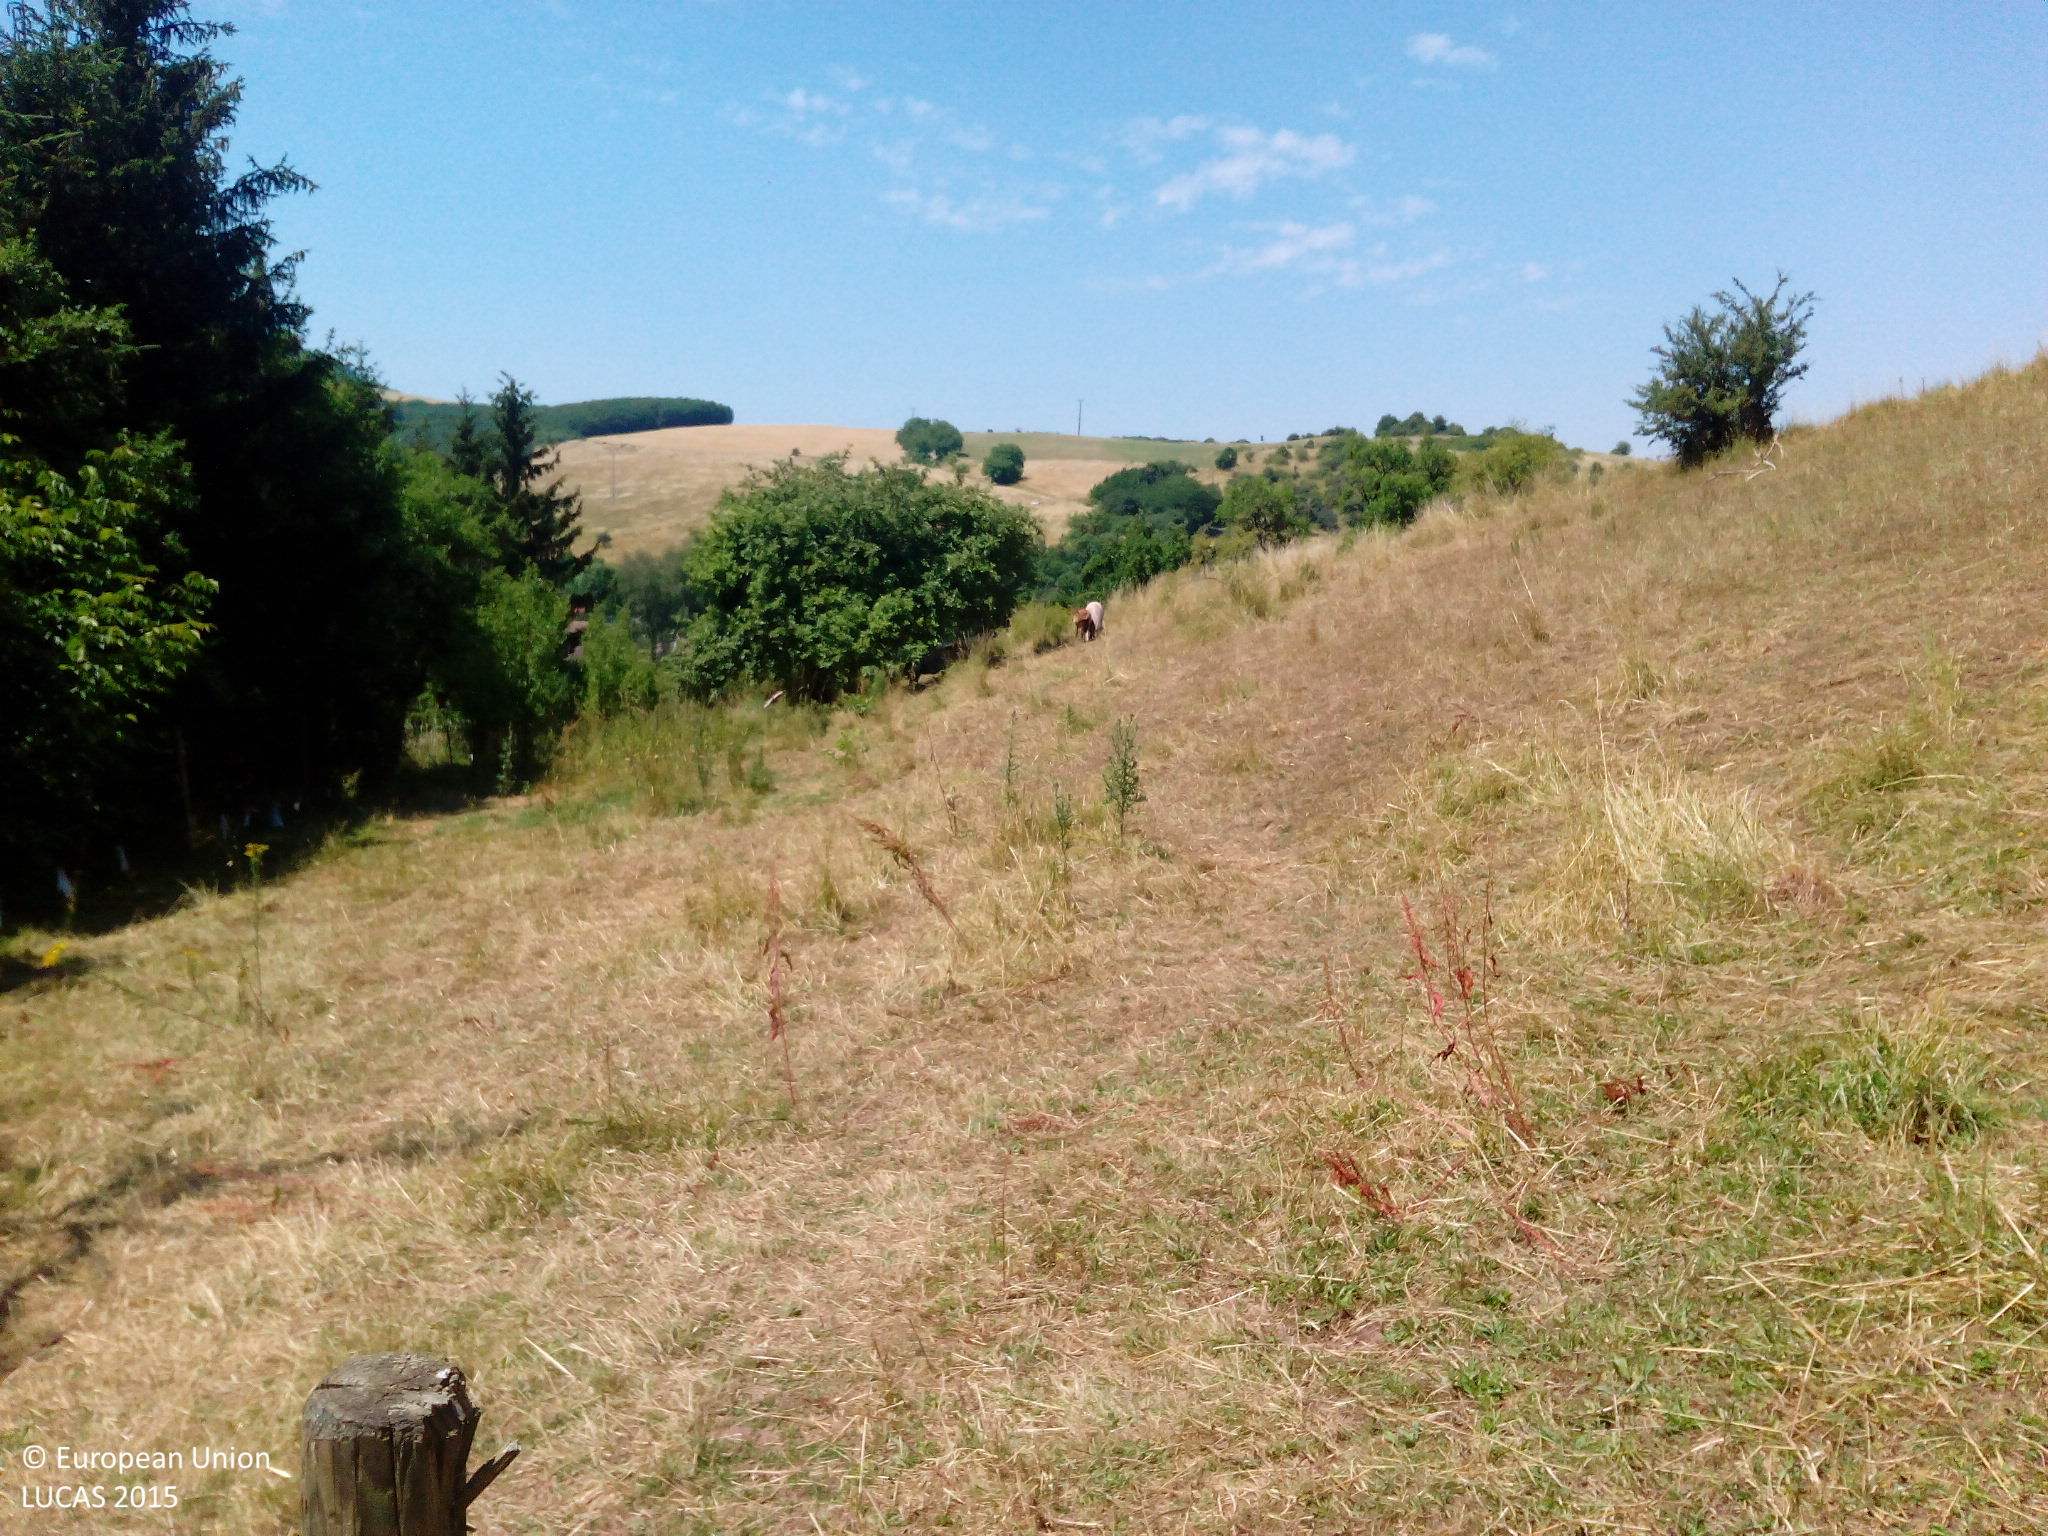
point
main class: Grassland
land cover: Grassland with sparse tree/shrub cover
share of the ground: > 75 %
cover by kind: herbaceous plants 80 %, unconsolidated bare surface 10 %, broadleaved forest trees 5 %, shrubs 5 %
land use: Agriculture (excluding fallow land and kitchen gardens)
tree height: < 5 m
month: July
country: DE
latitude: 49.5823
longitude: 7.5523
